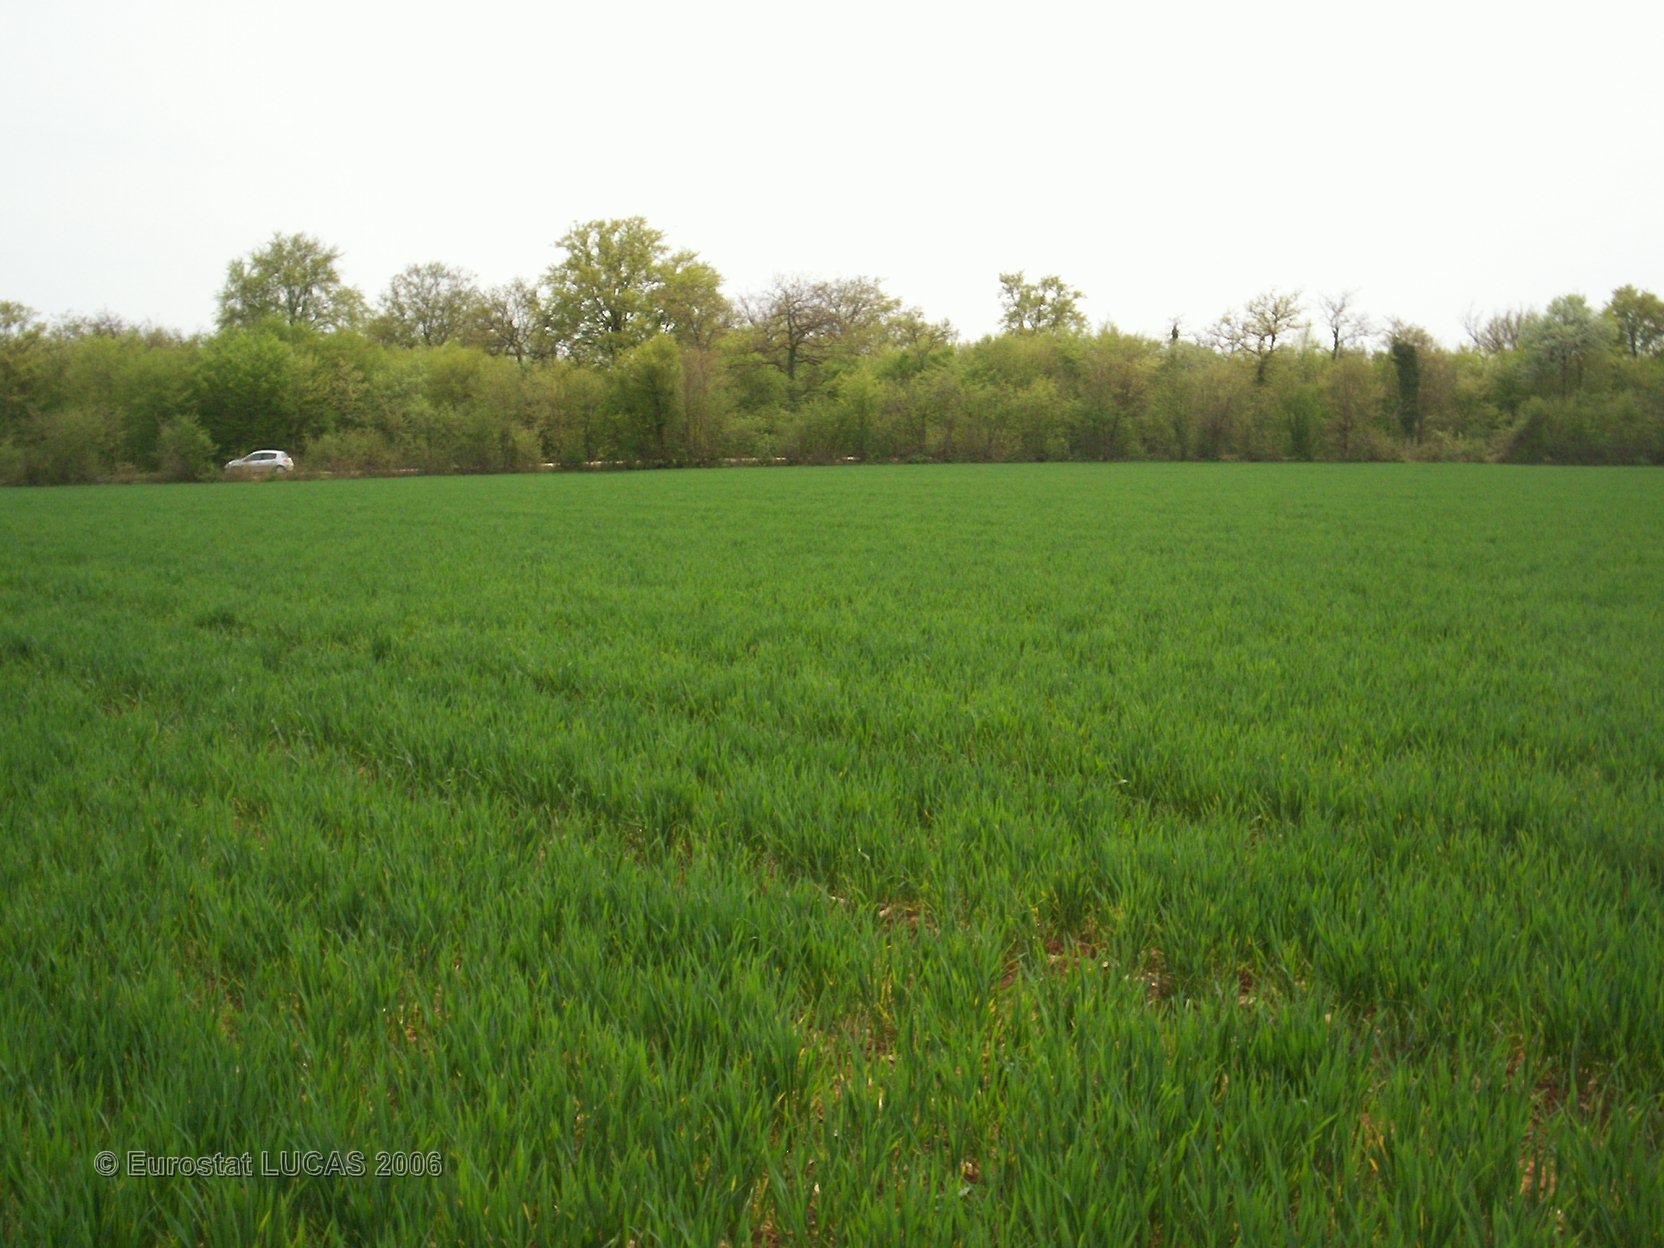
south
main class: Cropland
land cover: Common wheat
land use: Agriculture (excluding fallow land and kitchen gardens)
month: May
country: FR
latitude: 47.6932
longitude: 4.5760
